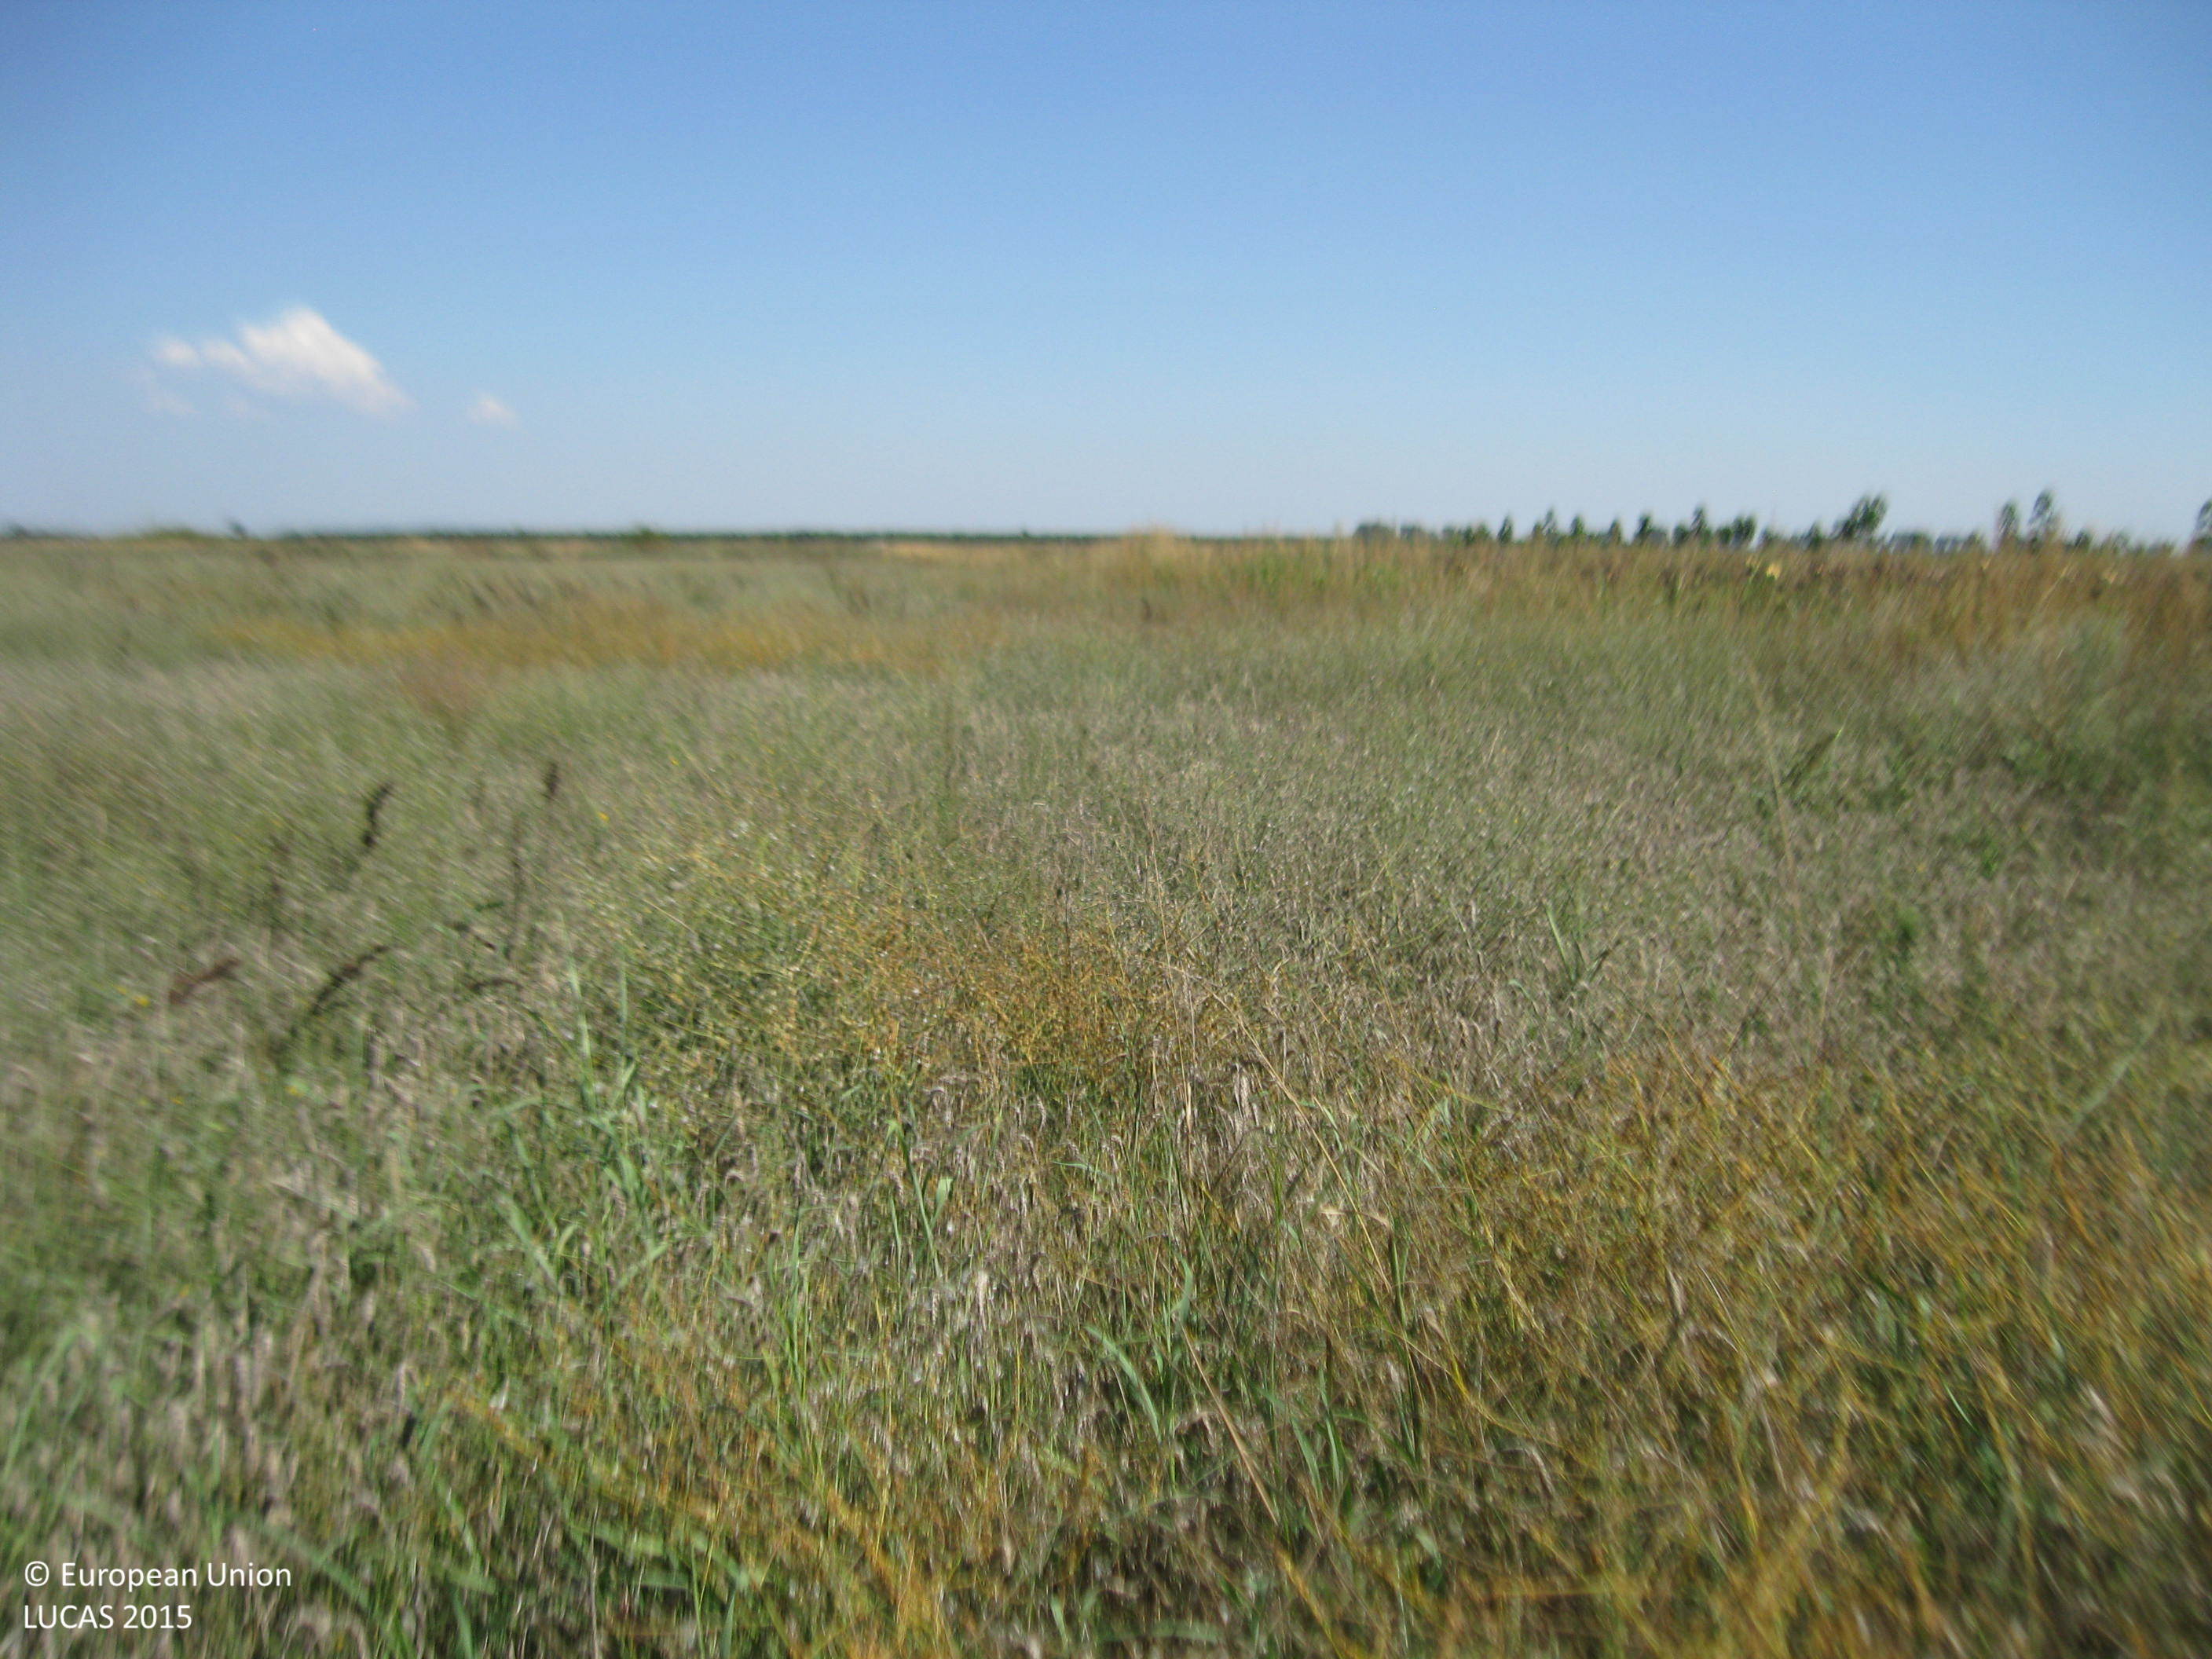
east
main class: Cropland
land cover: Common wheat
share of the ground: 10 - 25 %
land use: Agriculture (excluding fallow land and kitchen gardens)
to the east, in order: Common wheat; Spontaneously vegetated surfaces; Ditches and canals; Spontaneously vegetated surfaces; Tracks; Tomatoes
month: September
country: BG
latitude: 42.2732
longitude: 24.8099
